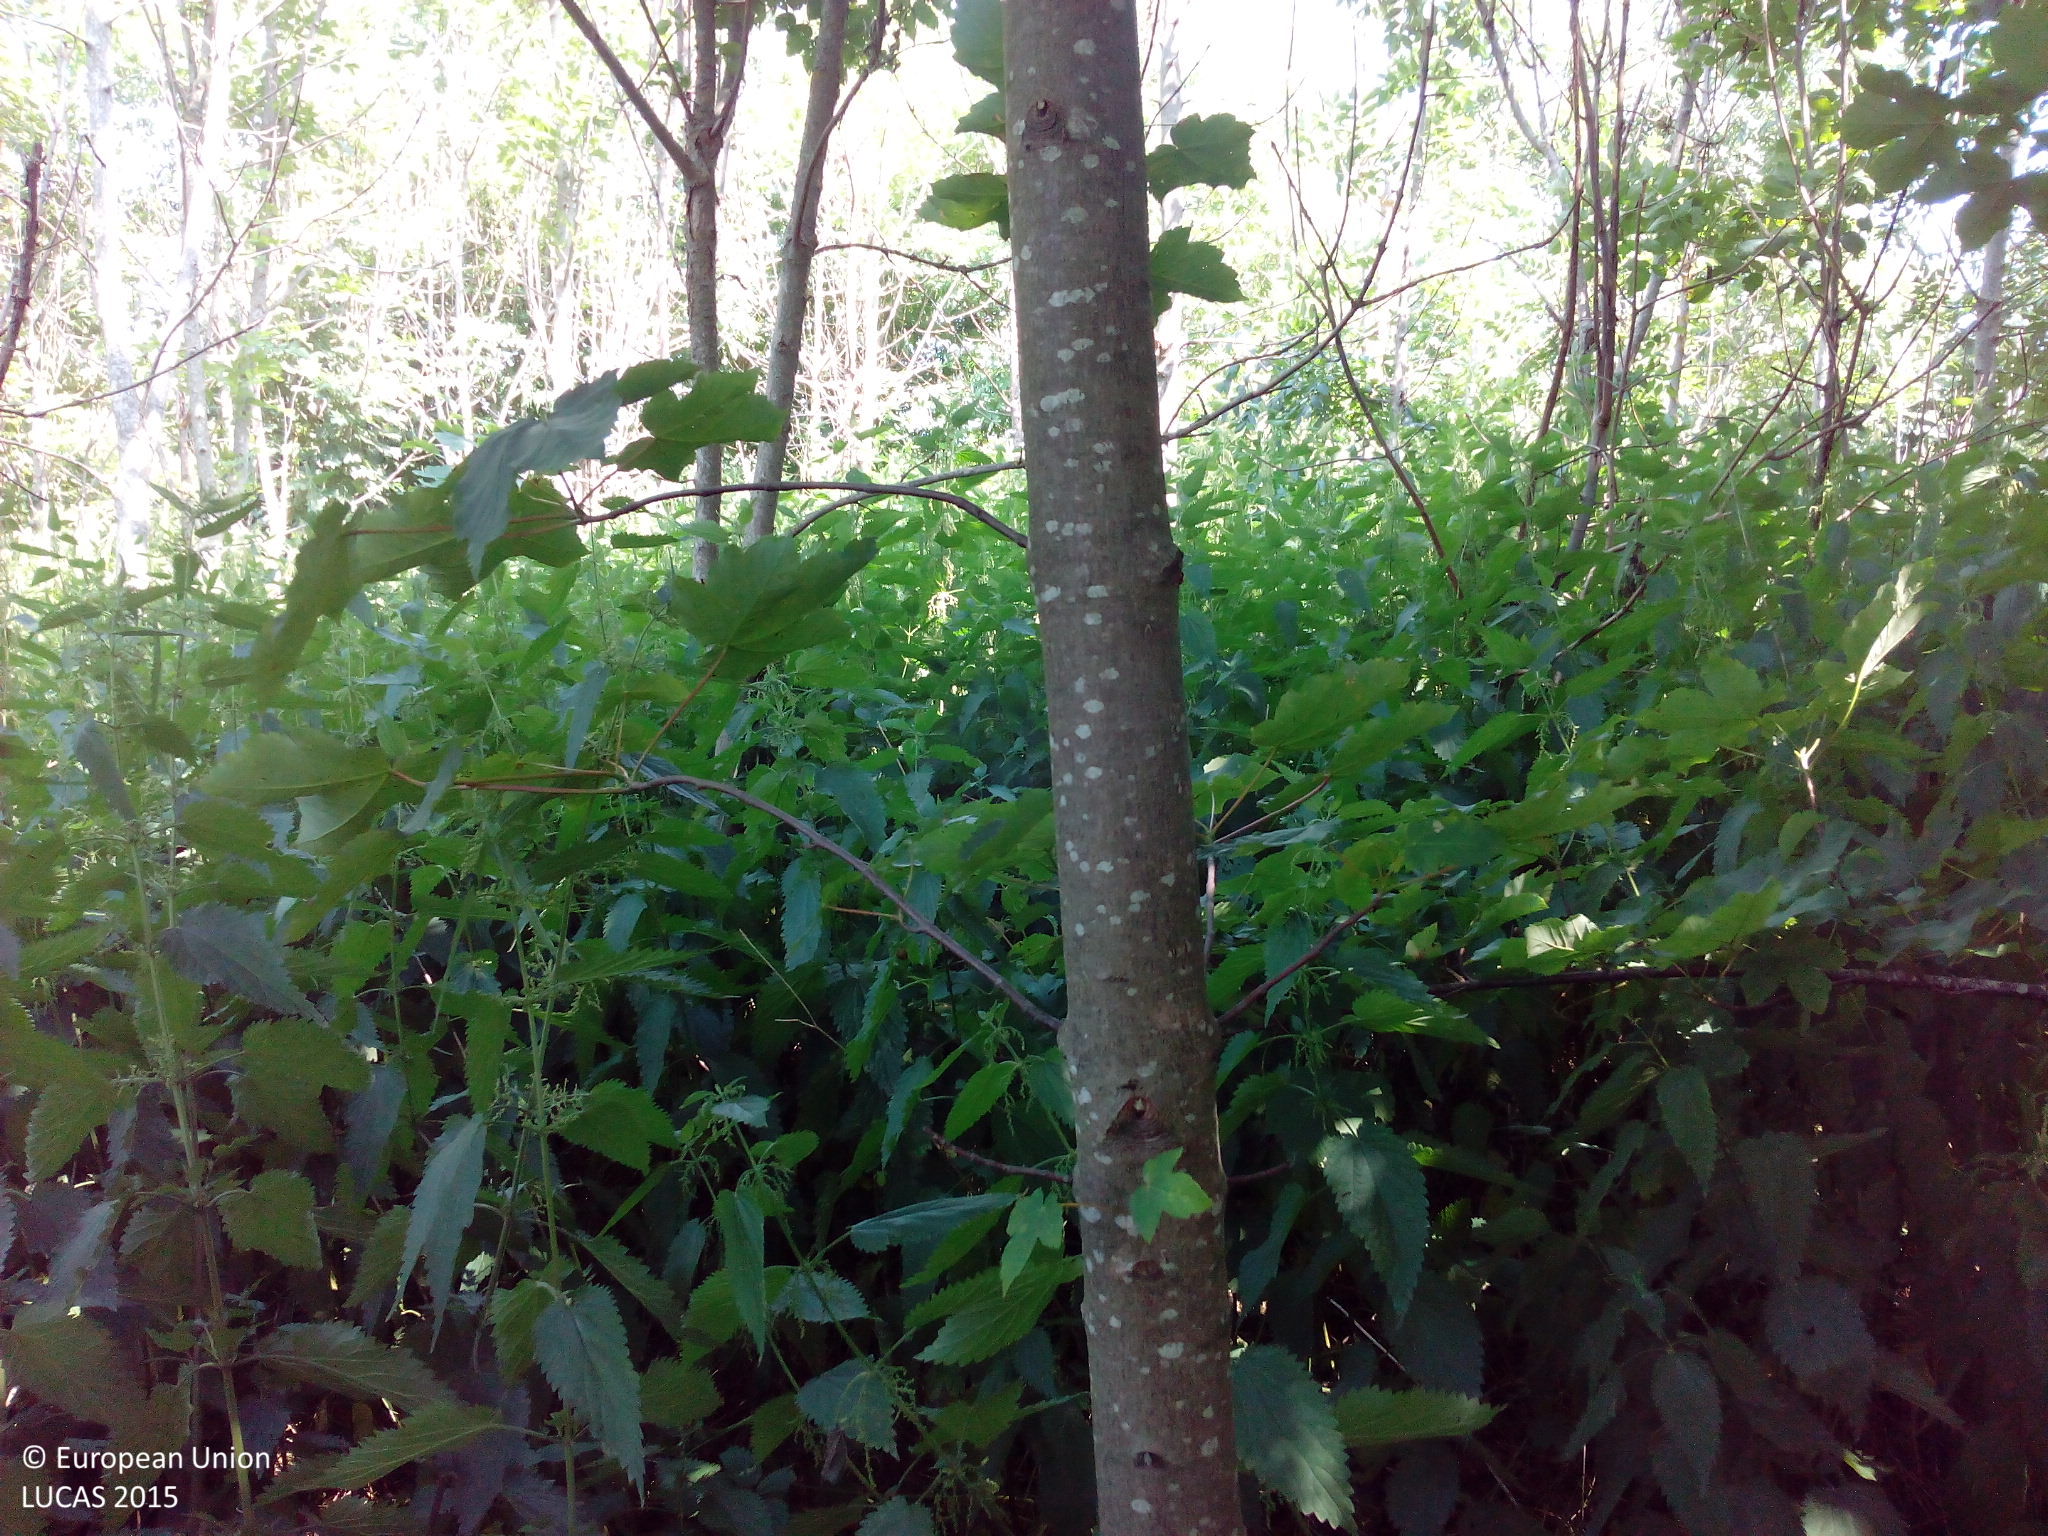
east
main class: Woodland
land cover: Broadleaved woodland
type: mesophytic deciduous forest
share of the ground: 50 - 75 %
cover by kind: broadleaved forest trees 75 %, herbaceous plants 25 %
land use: Forestry
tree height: < 5 m
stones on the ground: < 10 %
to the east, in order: Broadleaved woodland; Grassland without tree/shrub cover; Tracks; Grass margins; Spruce dominated coniferous woodland
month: July
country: DE
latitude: 48.5290
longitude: 9.6887
